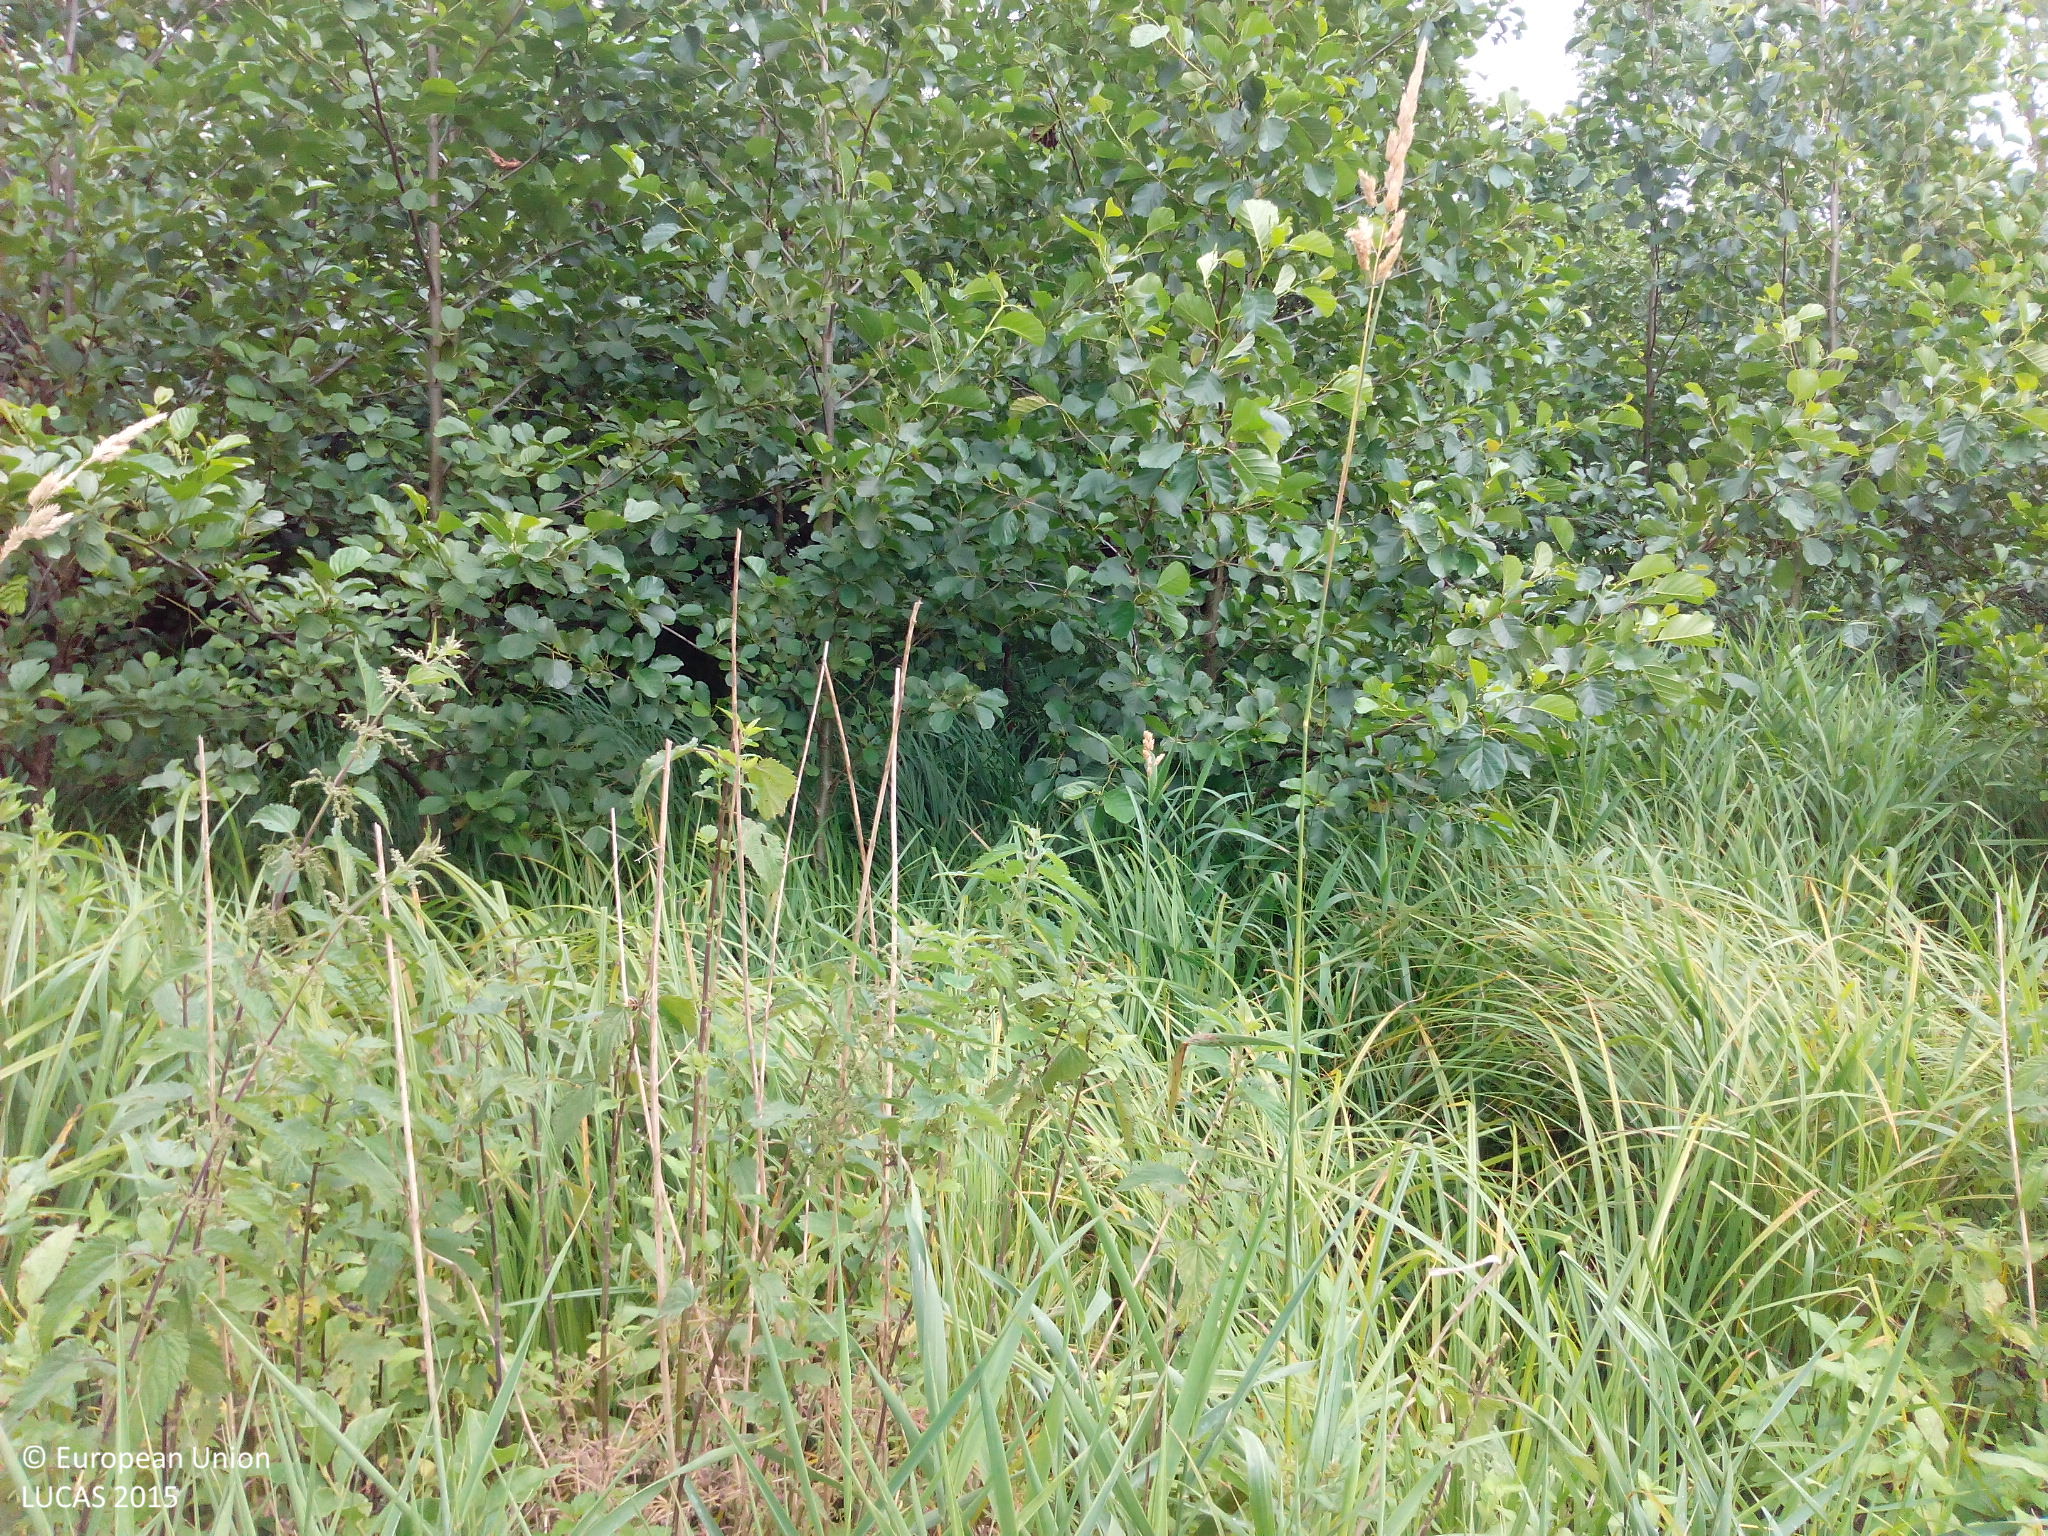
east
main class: Woodland
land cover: Broadleaved woodland
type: mesophytic deciduous forest
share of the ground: 50 - 75 %
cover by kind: broadleaved forest trees 60 %, herbaceous plants 40 %
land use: Forestry
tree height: > 5 m
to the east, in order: Broadleaved woodland; Fences; Ditches and canals; Grass margins; Paved roads, cycling and walking lanes; Grass margins; Ditches and canals; Broadleaved woodland; Grassland without tree/shrub cover
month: July
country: DE
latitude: 54.2527
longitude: 12.7157
